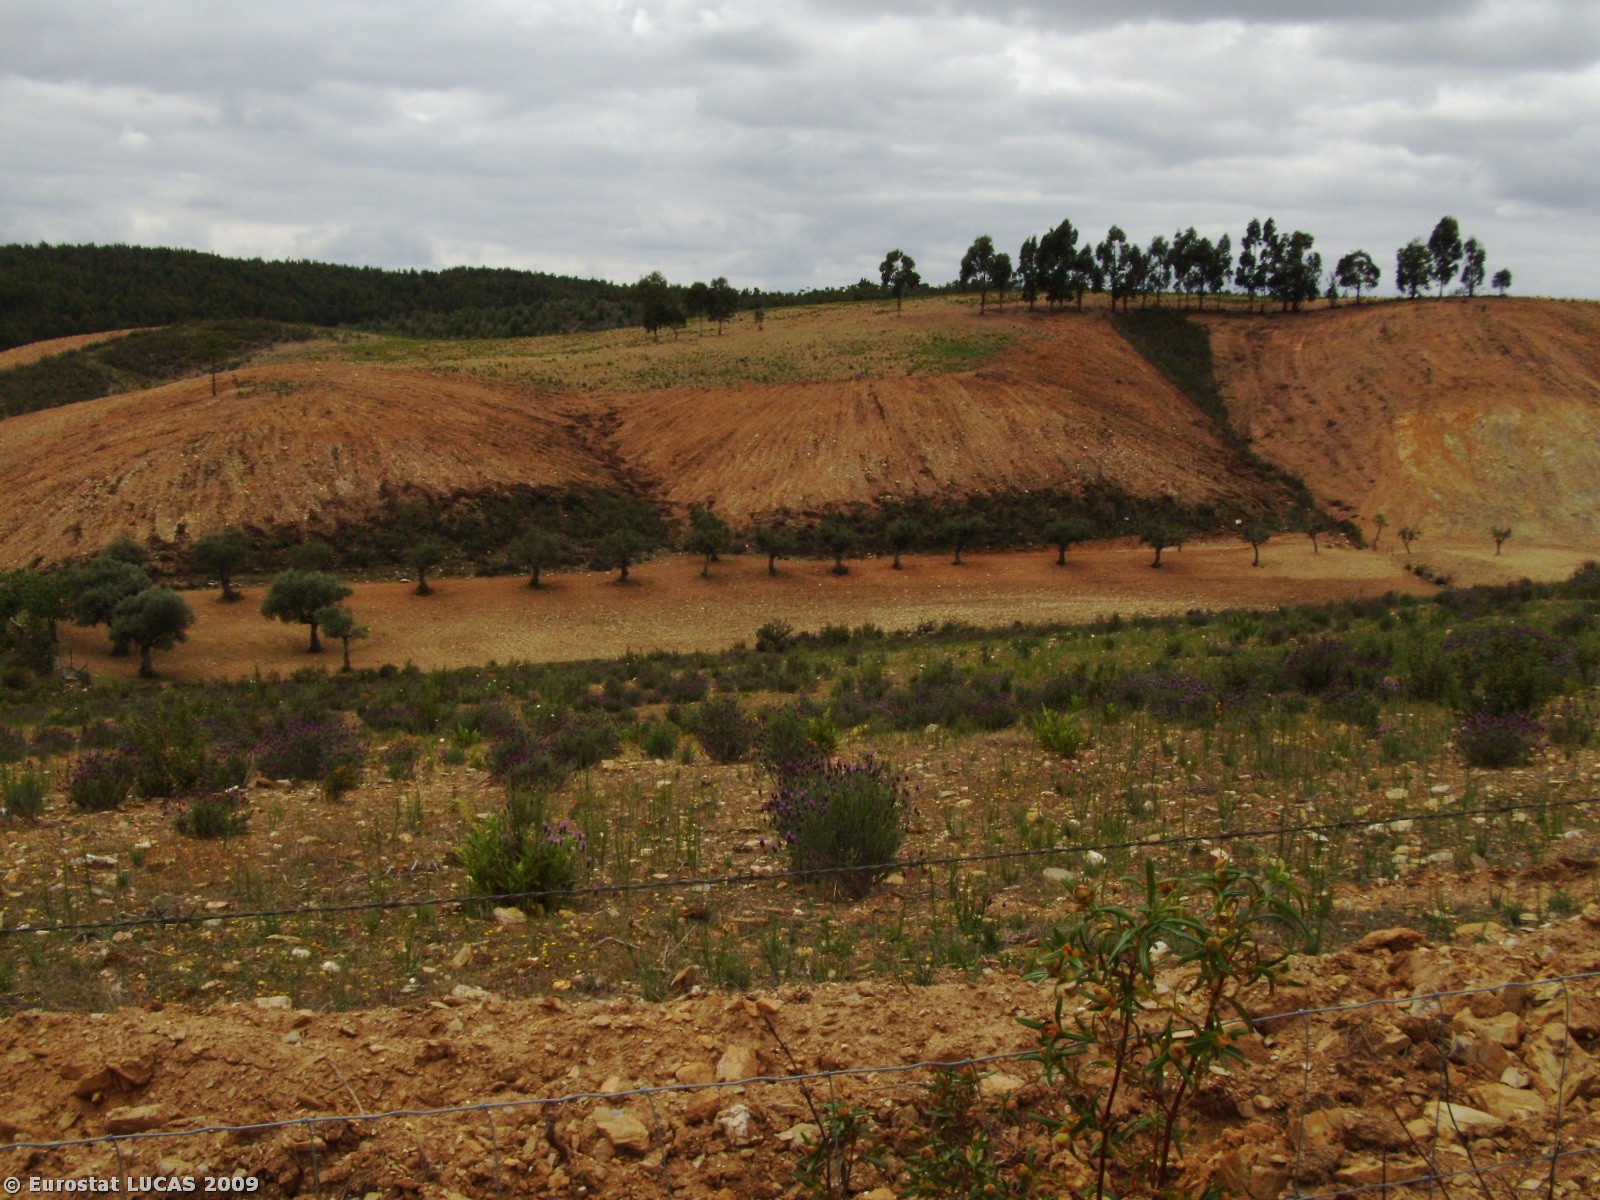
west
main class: Grassland
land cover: Spontaneously vegetated surfaces
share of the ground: > 75 %
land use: Fallow land
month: April
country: PT
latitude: 39.7865
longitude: -7.5092
